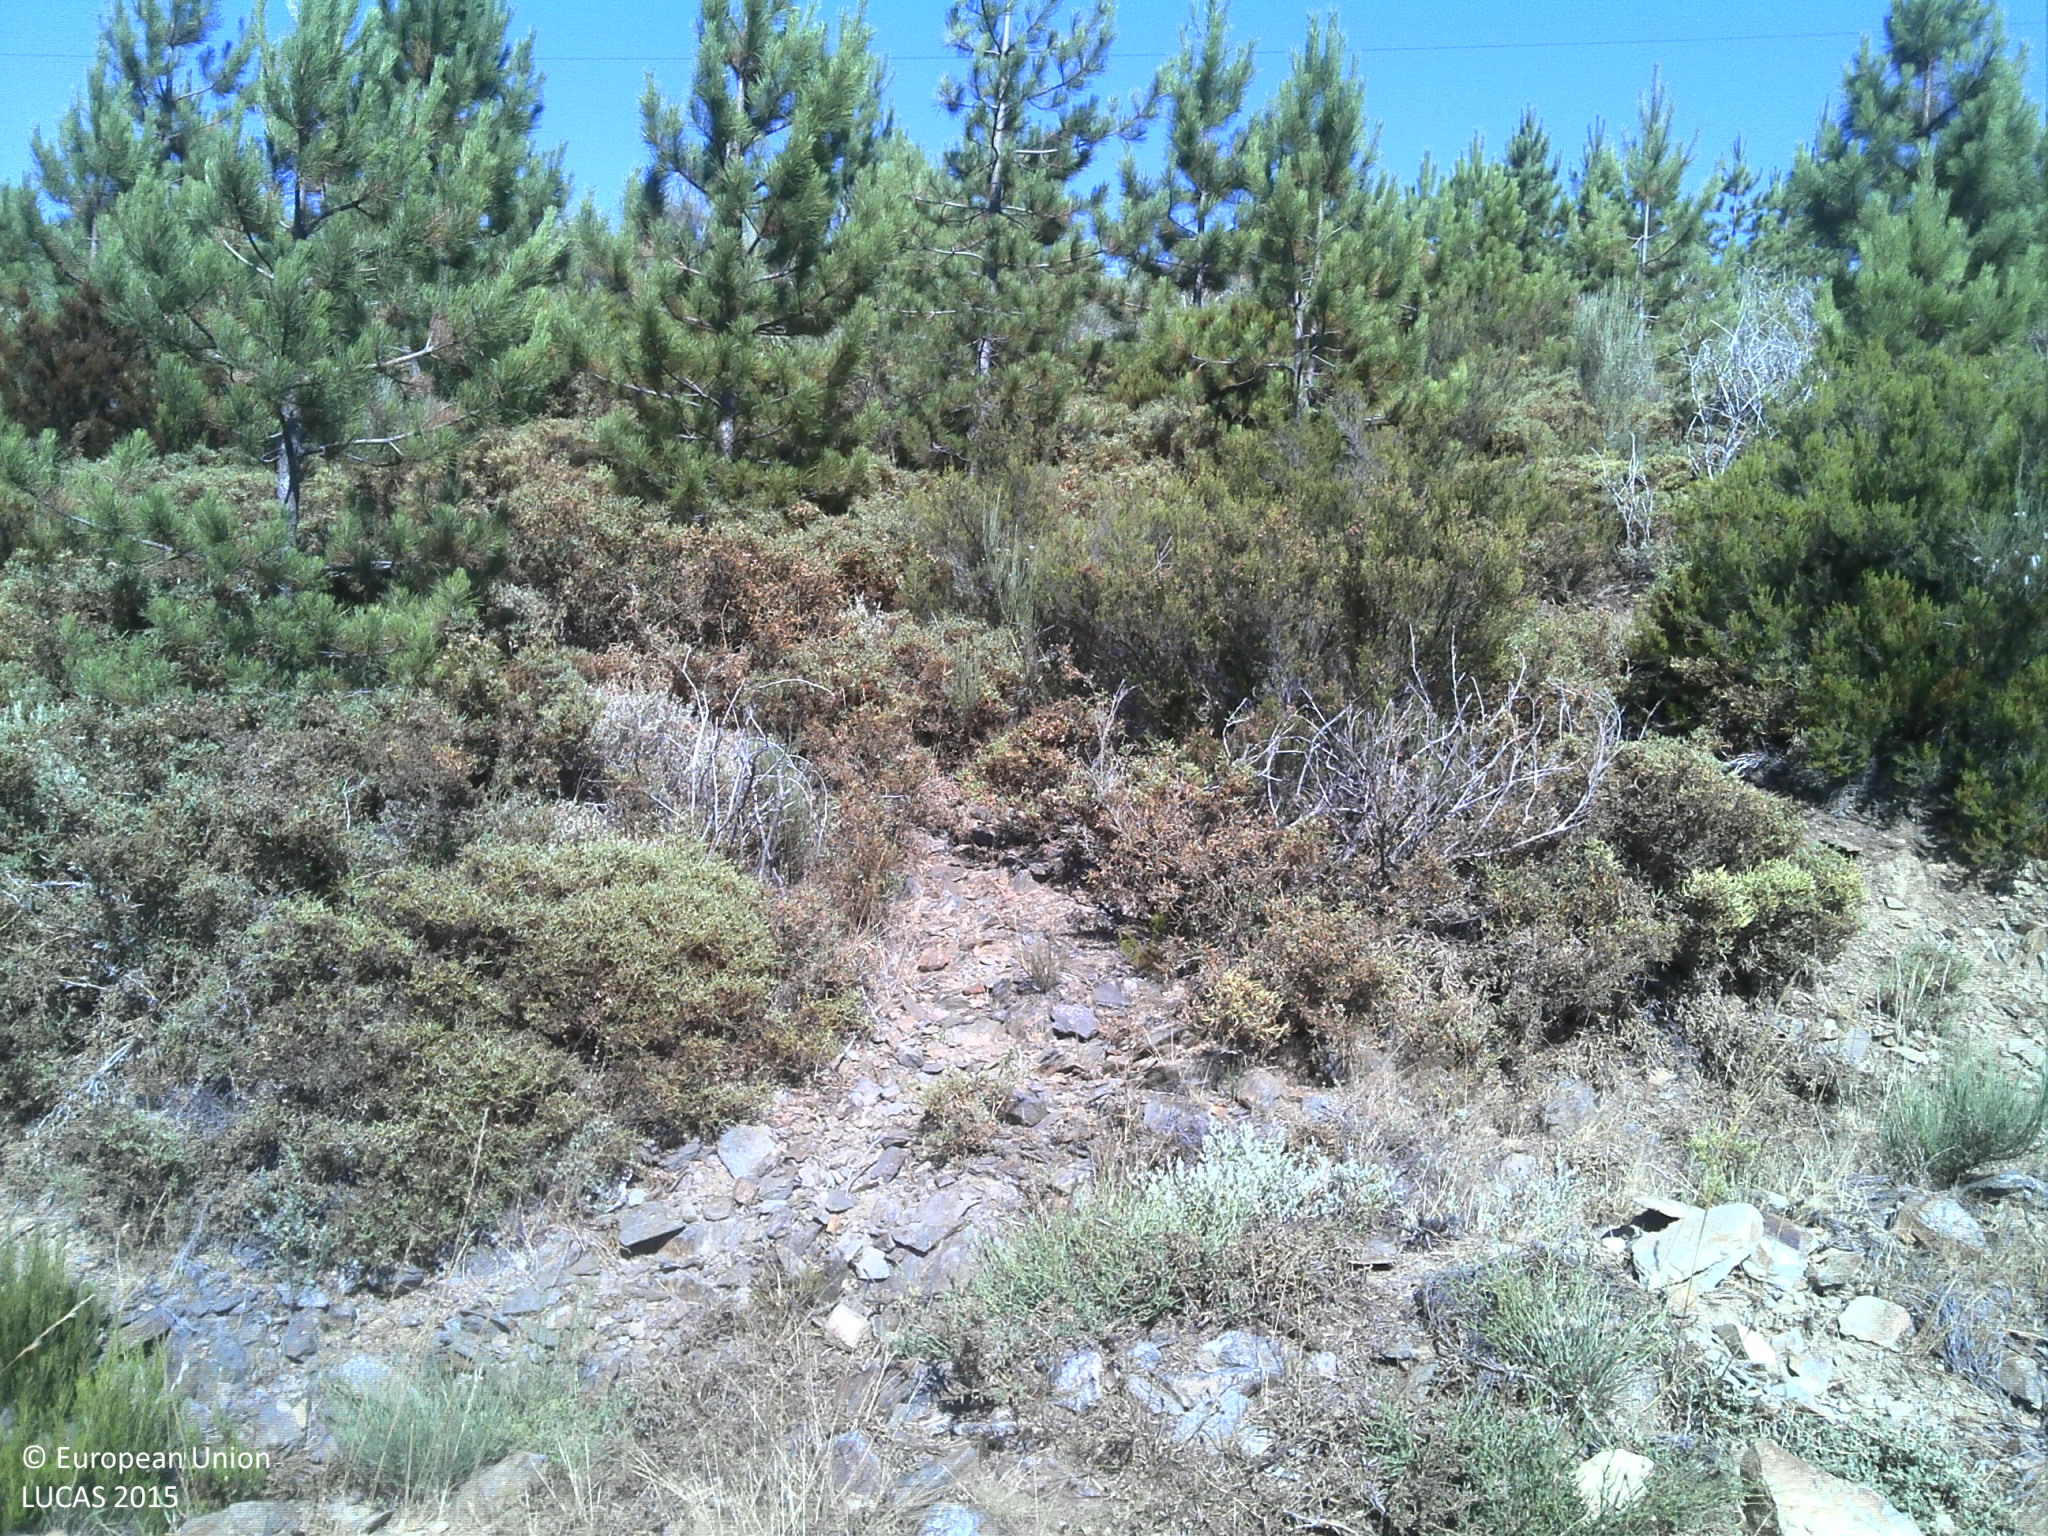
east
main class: Shrubland
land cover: Shrubland with sparse tree cover
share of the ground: 50 - 75 %
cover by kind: shrubs 75 %, unconsolidated bare surface 15 %, coniferous forest trees 5 %
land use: Semi-natural and natural areas not in use
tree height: > 5 m
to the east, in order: Shrubland with sparse tree cover; Pine dominated coniferous woodland; Tracks; Pine dominated coniferous woodland; Shrubland with sparse tree cover; Rivers and streams; Shrubland with sparse tree cover
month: July
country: PT
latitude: 40.4261
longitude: -7.5436
